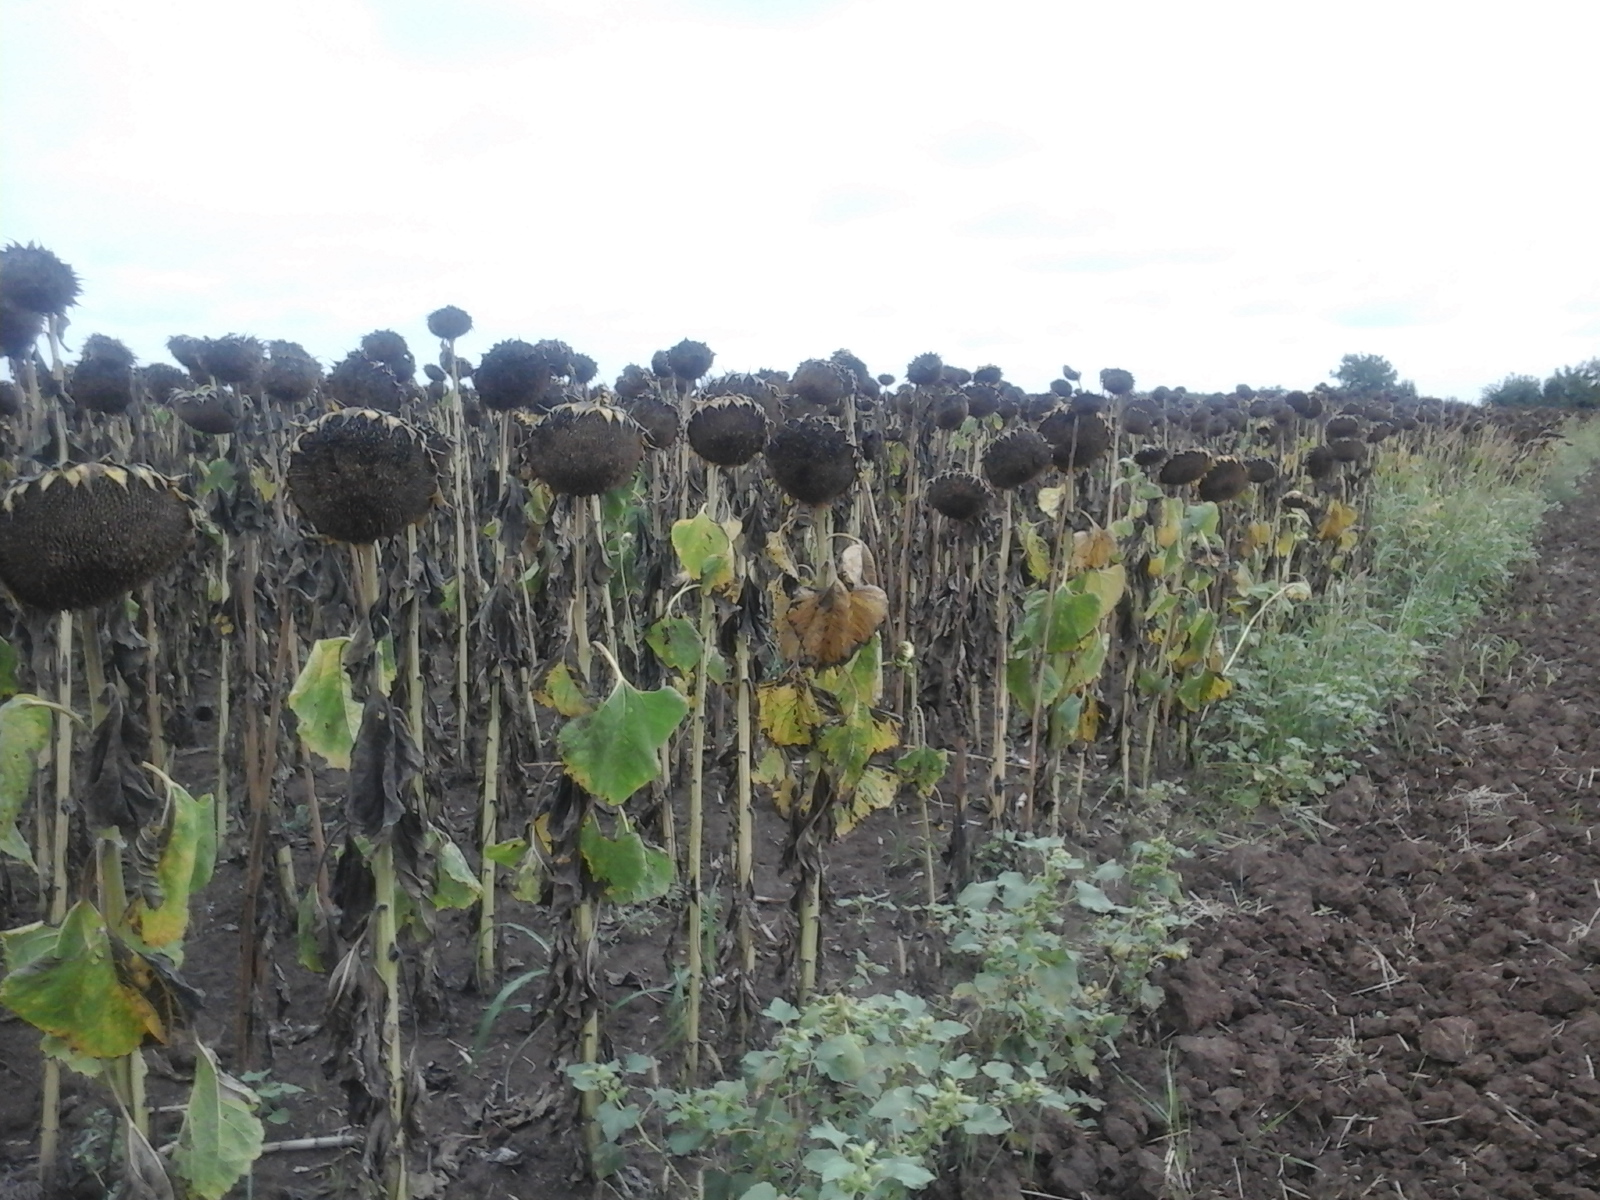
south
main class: Cropland
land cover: Sunflower
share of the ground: > 75 %
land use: Agriculture (excluding fallow land and kitchen gardens)
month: September
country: RO
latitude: 47.2108
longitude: 21.9165
